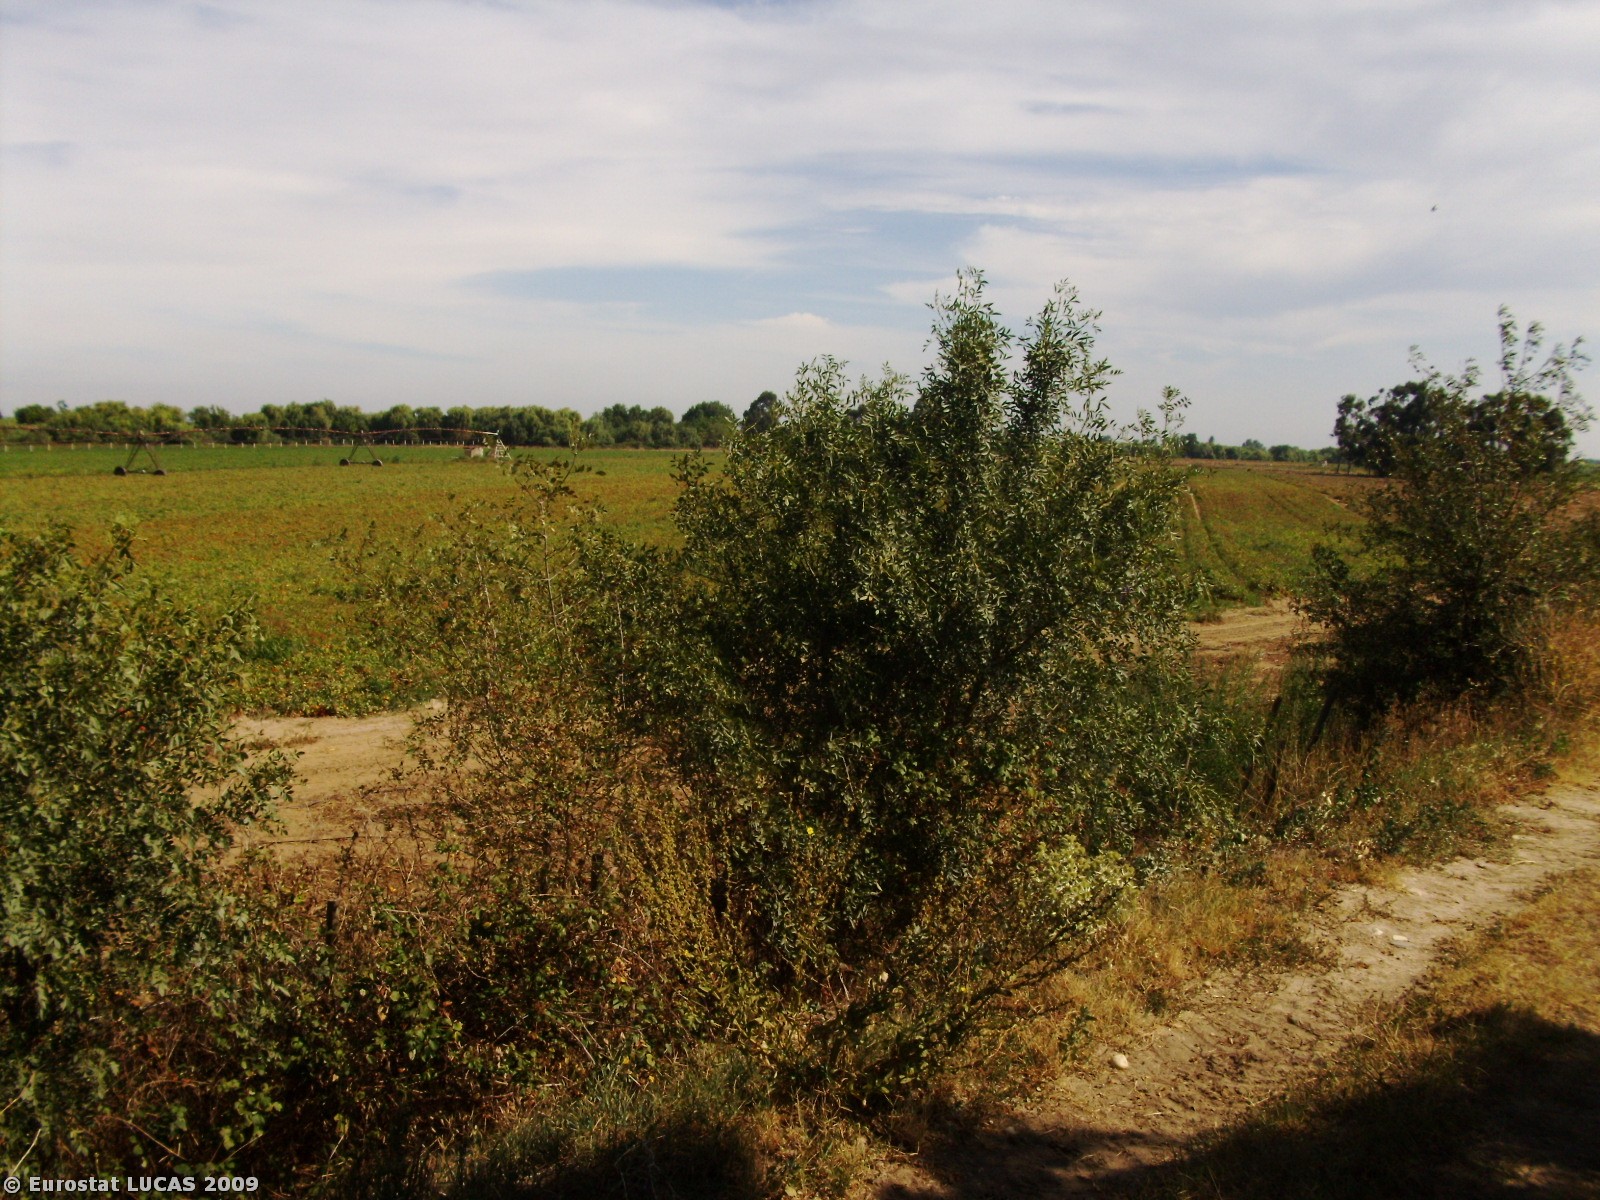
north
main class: Grassland
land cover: Grassland with sparse tree/shrub cover
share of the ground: 50 - 75 %
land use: Agriculture (excluding fallow land and kitchen gardens)
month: August
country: PT
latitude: 39.0423
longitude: -8.8004
